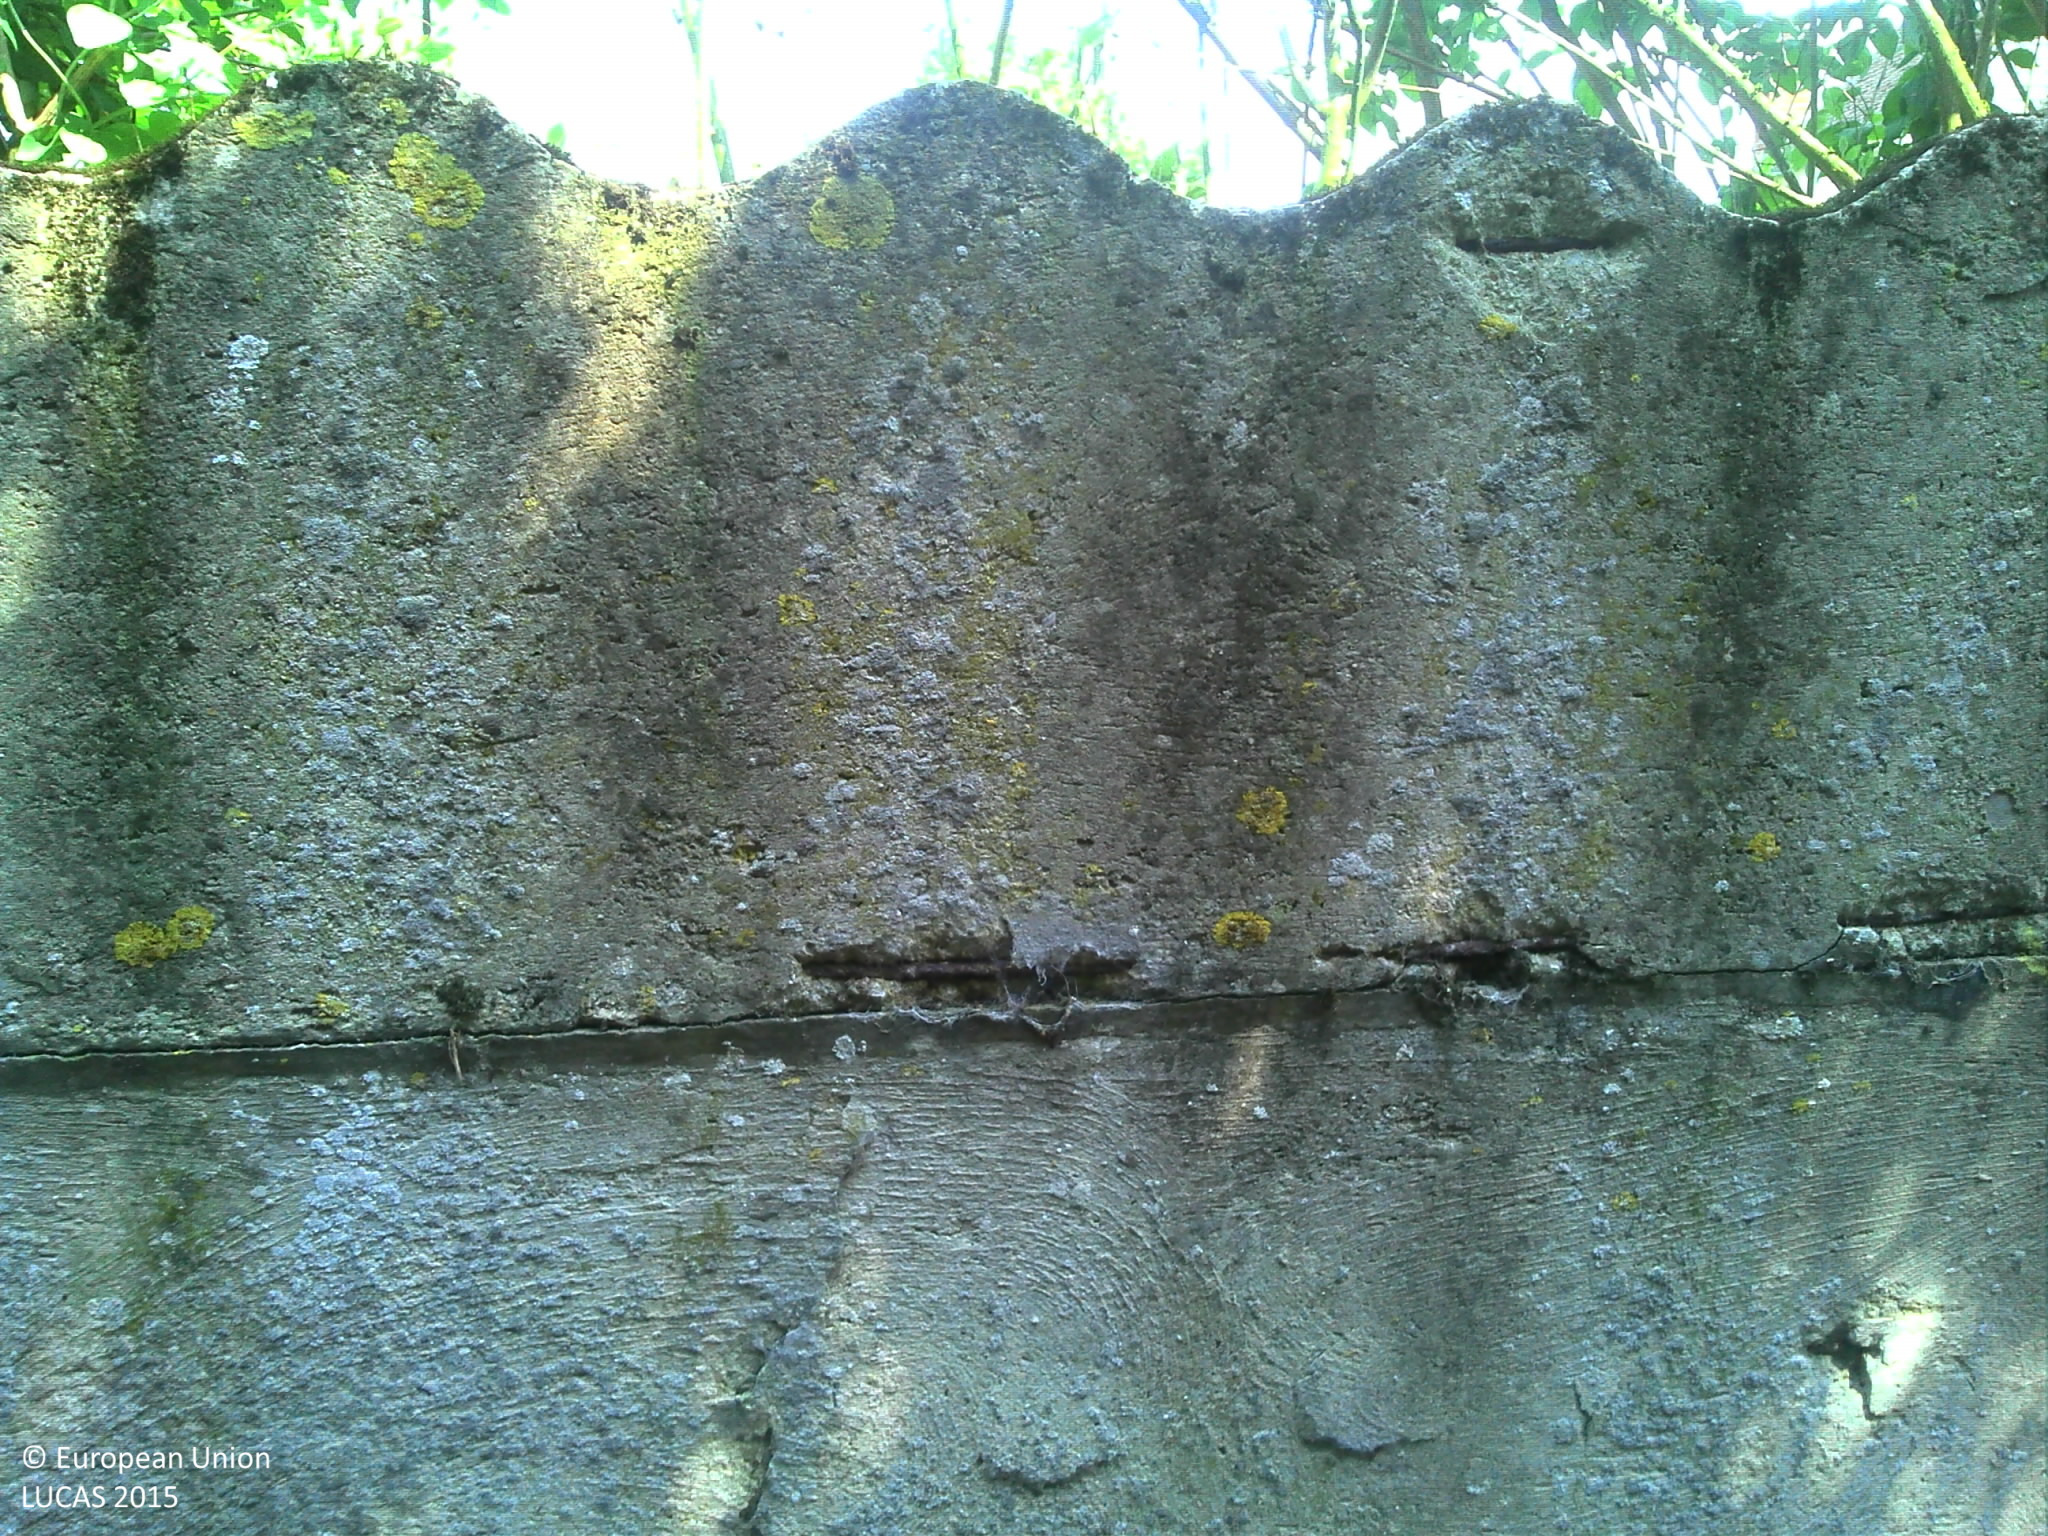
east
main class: Grassland
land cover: Grassland with sparse tree/shrub cover
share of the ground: > 75 %
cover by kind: herbaceous plants 90 %, broadleaved forest trees 5 %, shrubs 5 %
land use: Residential
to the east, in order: Grassland with sparse tree/shrub cover; Artificial constructions in urban areas
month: June
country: FR
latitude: 49.7084
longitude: 4.1292
